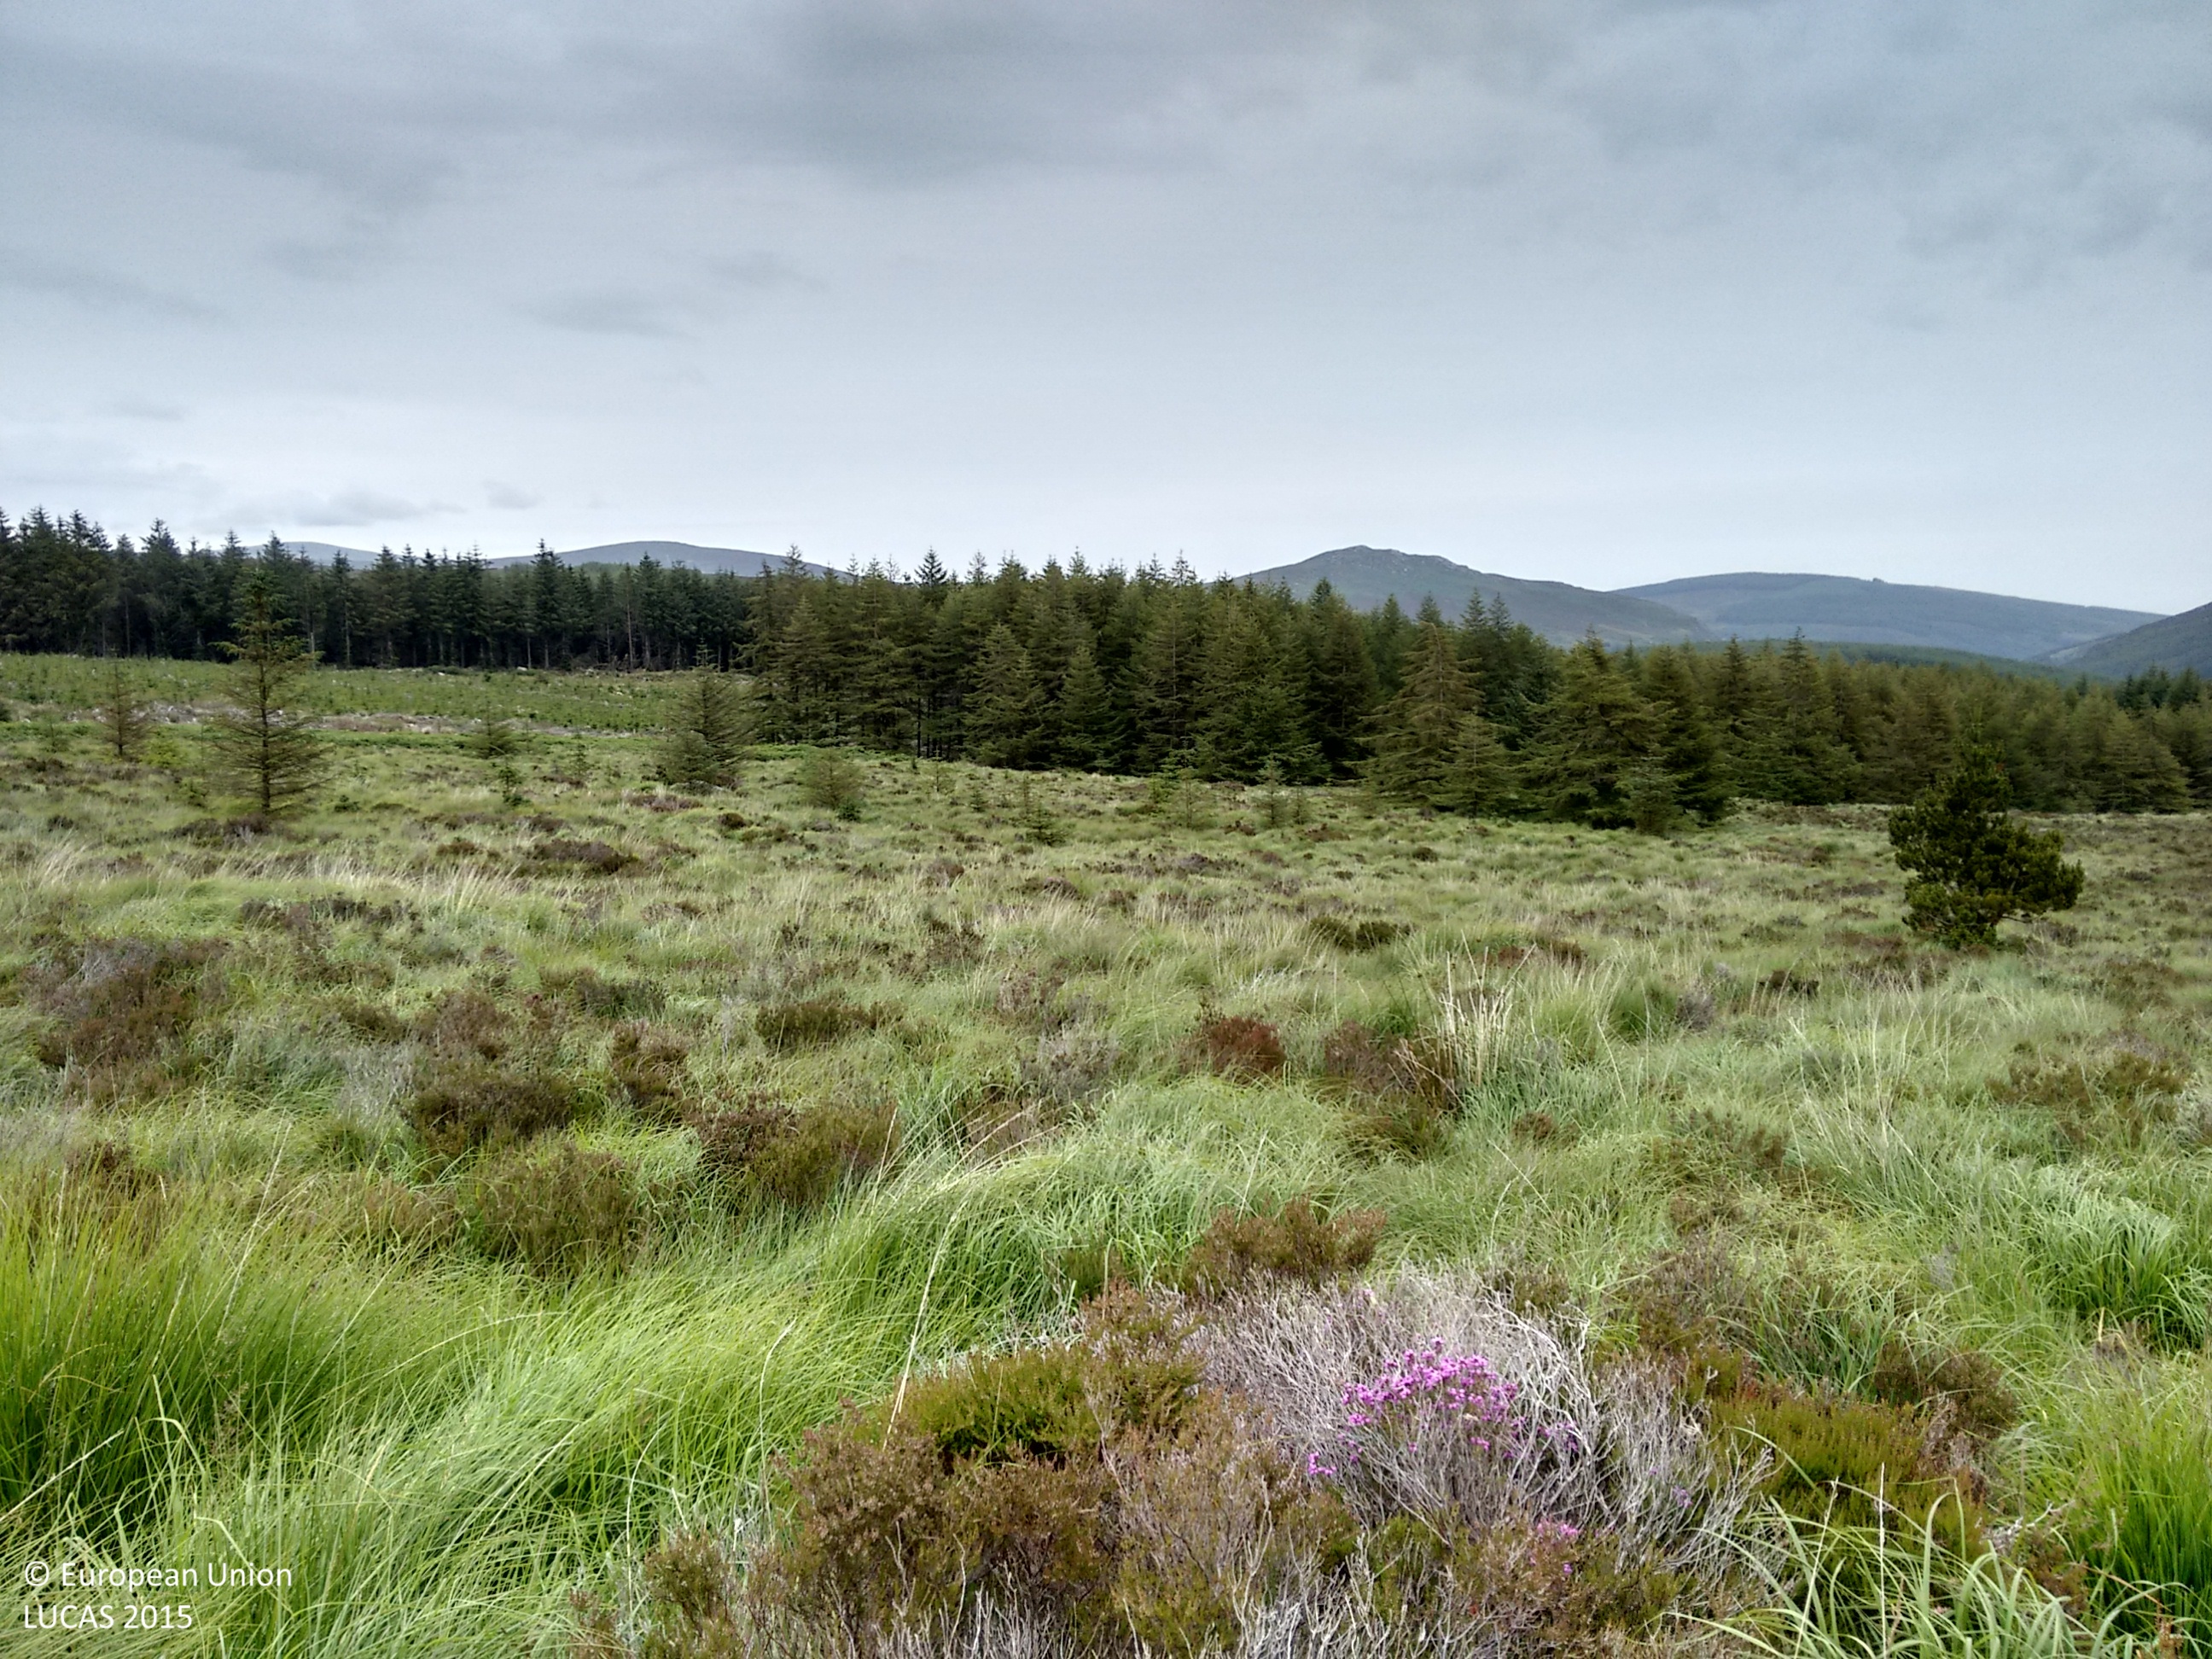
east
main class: Shrubland
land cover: Shrubland without tree cover
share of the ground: > 75 %
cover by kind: shrubs 60 %, herbaceous plants 40 %
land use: Semi-natural and natural areas not in use
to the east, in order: Shrubland without tree cover; Grassland with sparse tree/shrub cover; Spruce dominated mixed woodland; Rivers and streams; Spruce dominated coniferous woodland
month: July
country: IE
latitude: 53.0875
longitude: -6.3527
